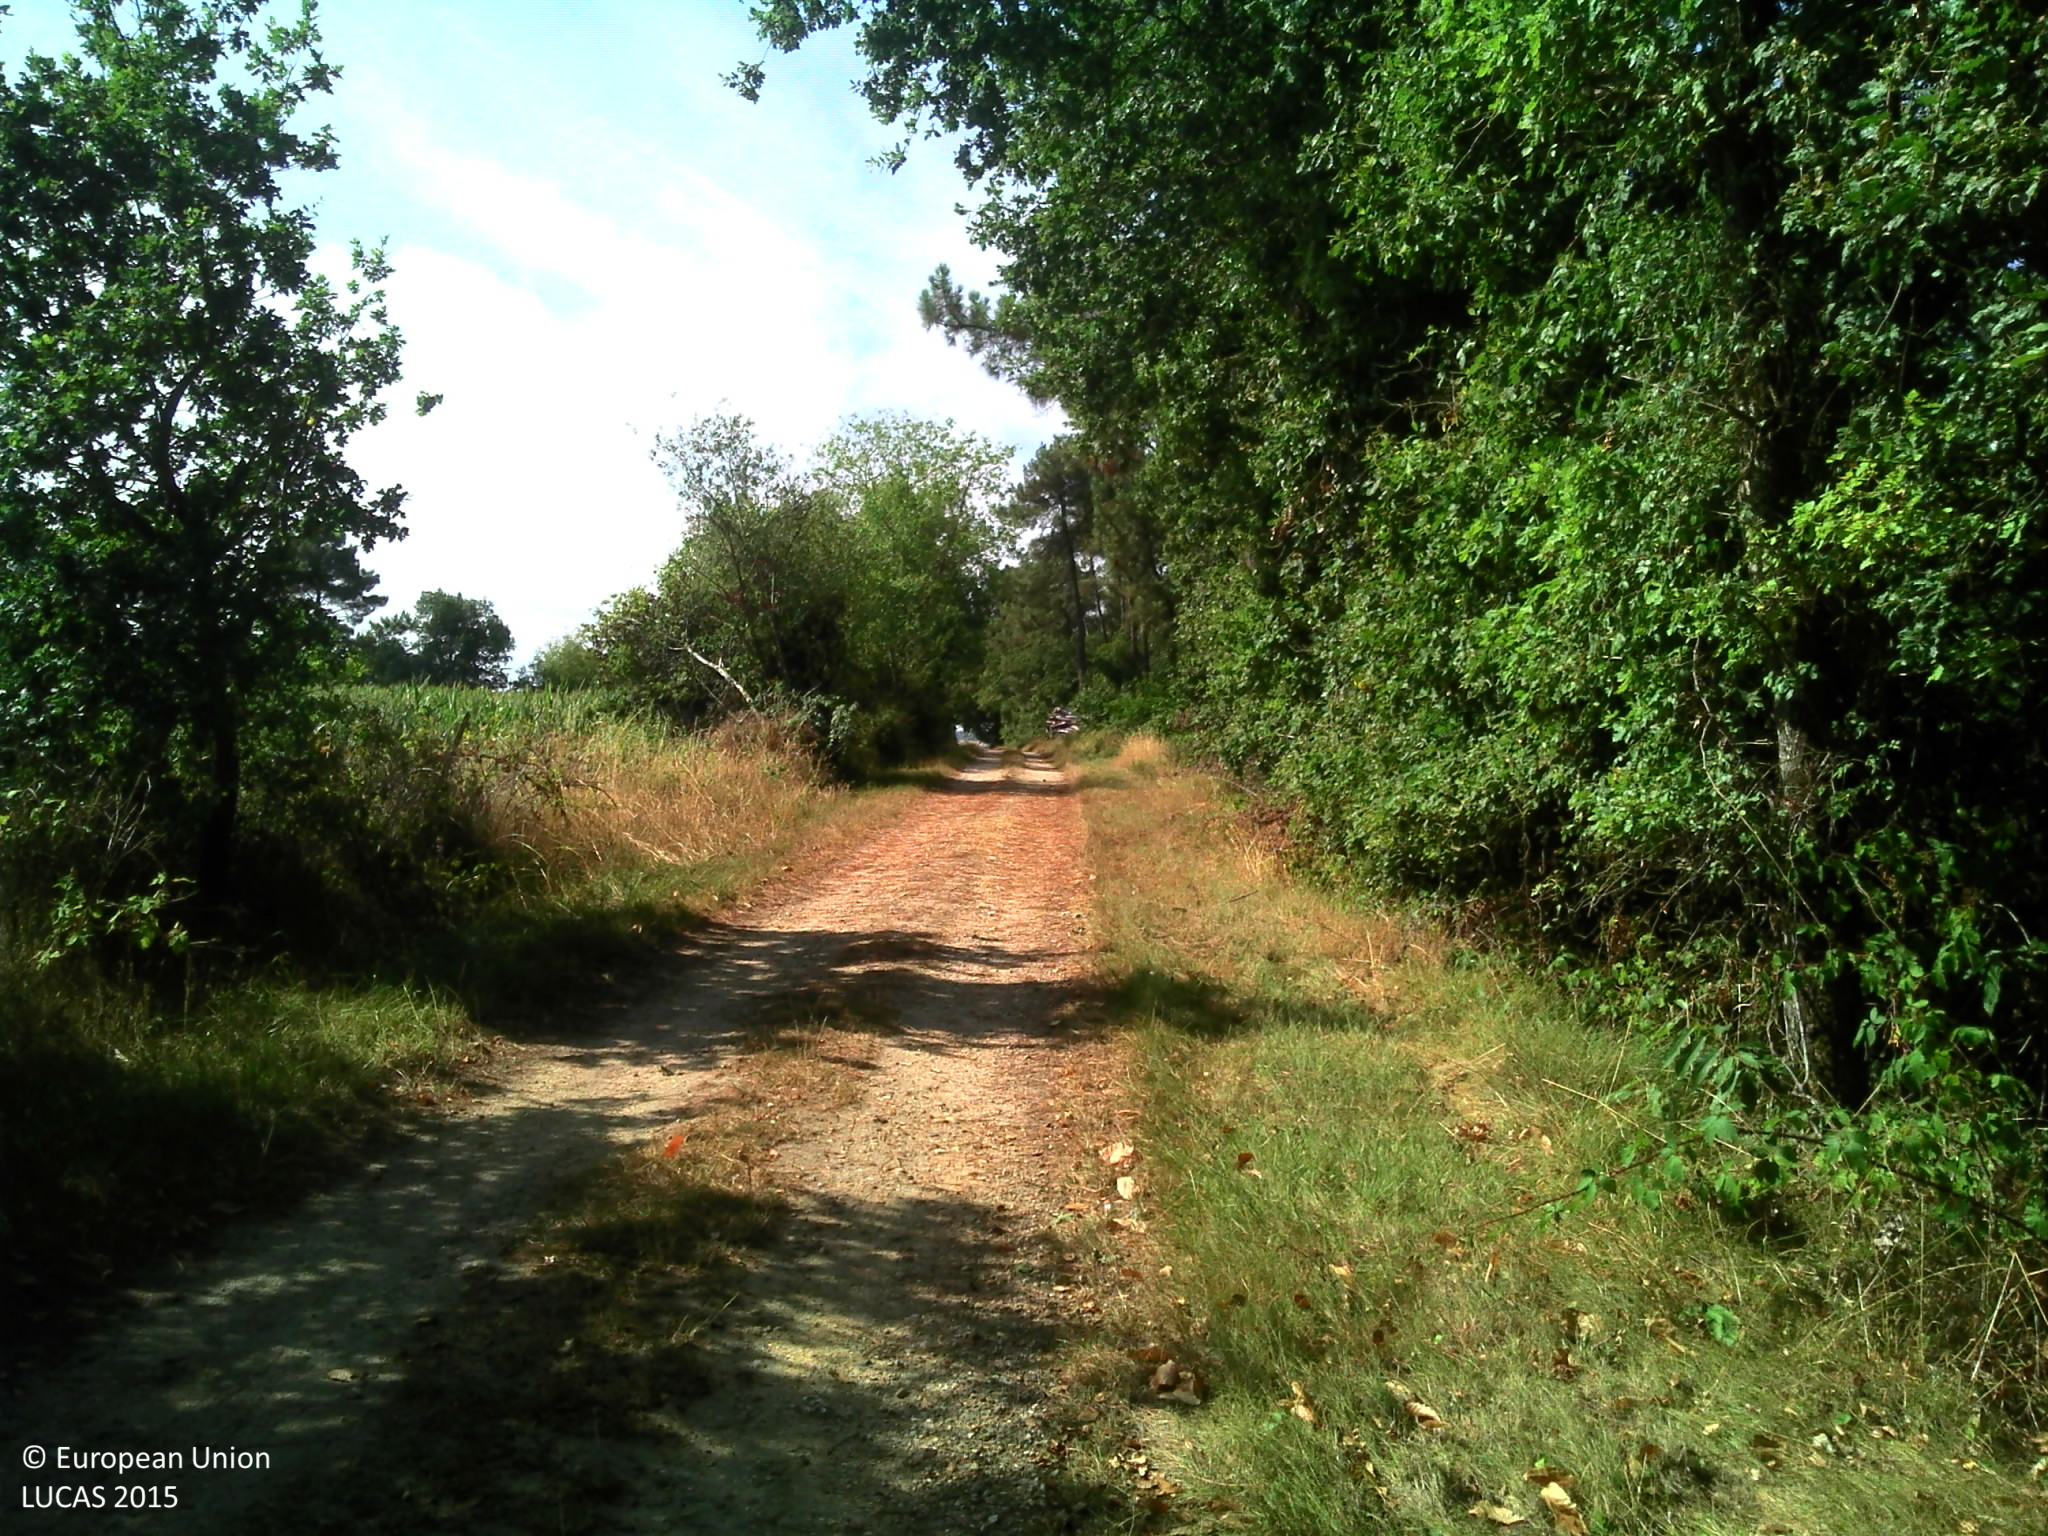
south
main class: Woodland
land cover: Pine dominated mixed woodland
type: mesophytic deciduous forest
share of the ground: > 75 %
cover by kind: broadleaved forest trees 50 %, coniferous forest trees 25 %, shrubs 10 %, herbaceous plants 10 %, lichens and mosses 5 %
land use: Forestry
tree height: > 5 m
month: July
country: FR
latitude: 47.0660
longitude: 0.4599
